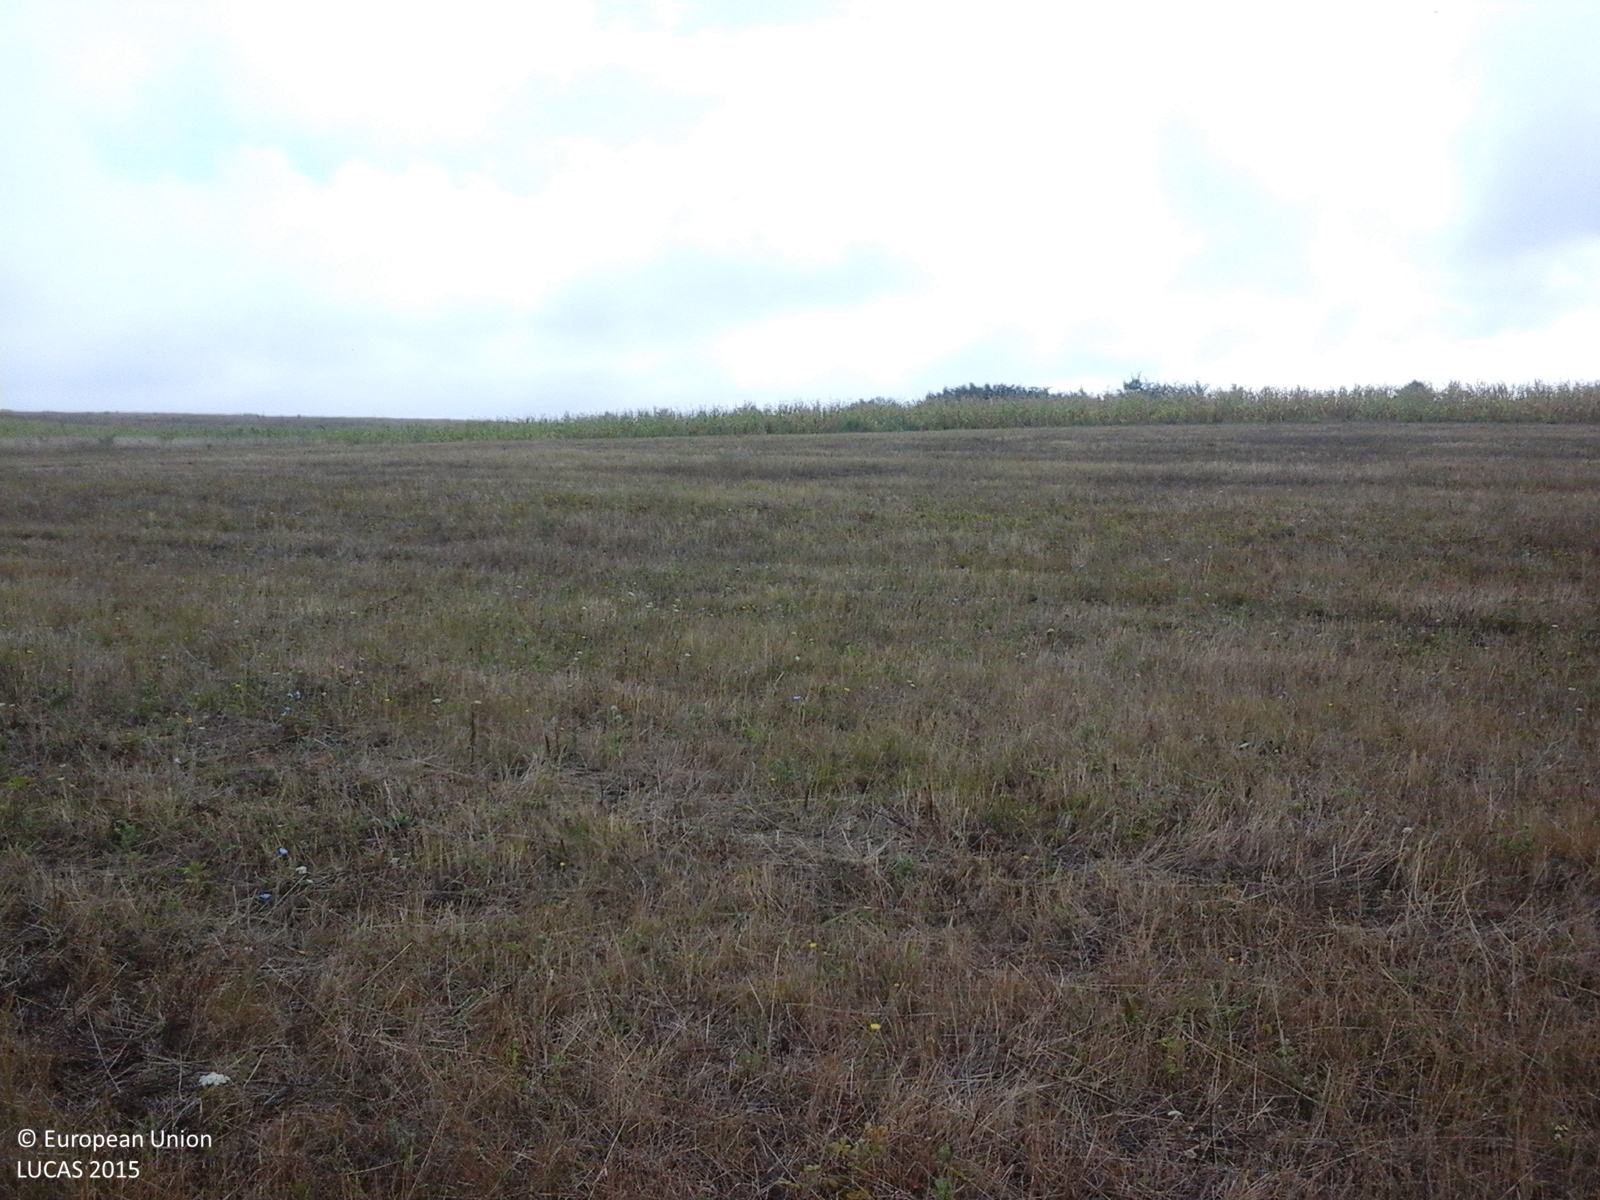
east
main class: Grassland
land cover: Grassland without tree/shrub cover
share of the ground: > 75 %
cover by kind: herbaceous plants 100 %
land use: Agriculture (excluding fallow land and kitchen gardens)
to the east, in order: Grassland without tree/shrub cover; Maize; Grassland without tree/shrub cover; Shrubland without tree cover; Grassland without tree/shrub cover
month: August
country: RO
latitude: 44.9822
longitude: 21.5063
